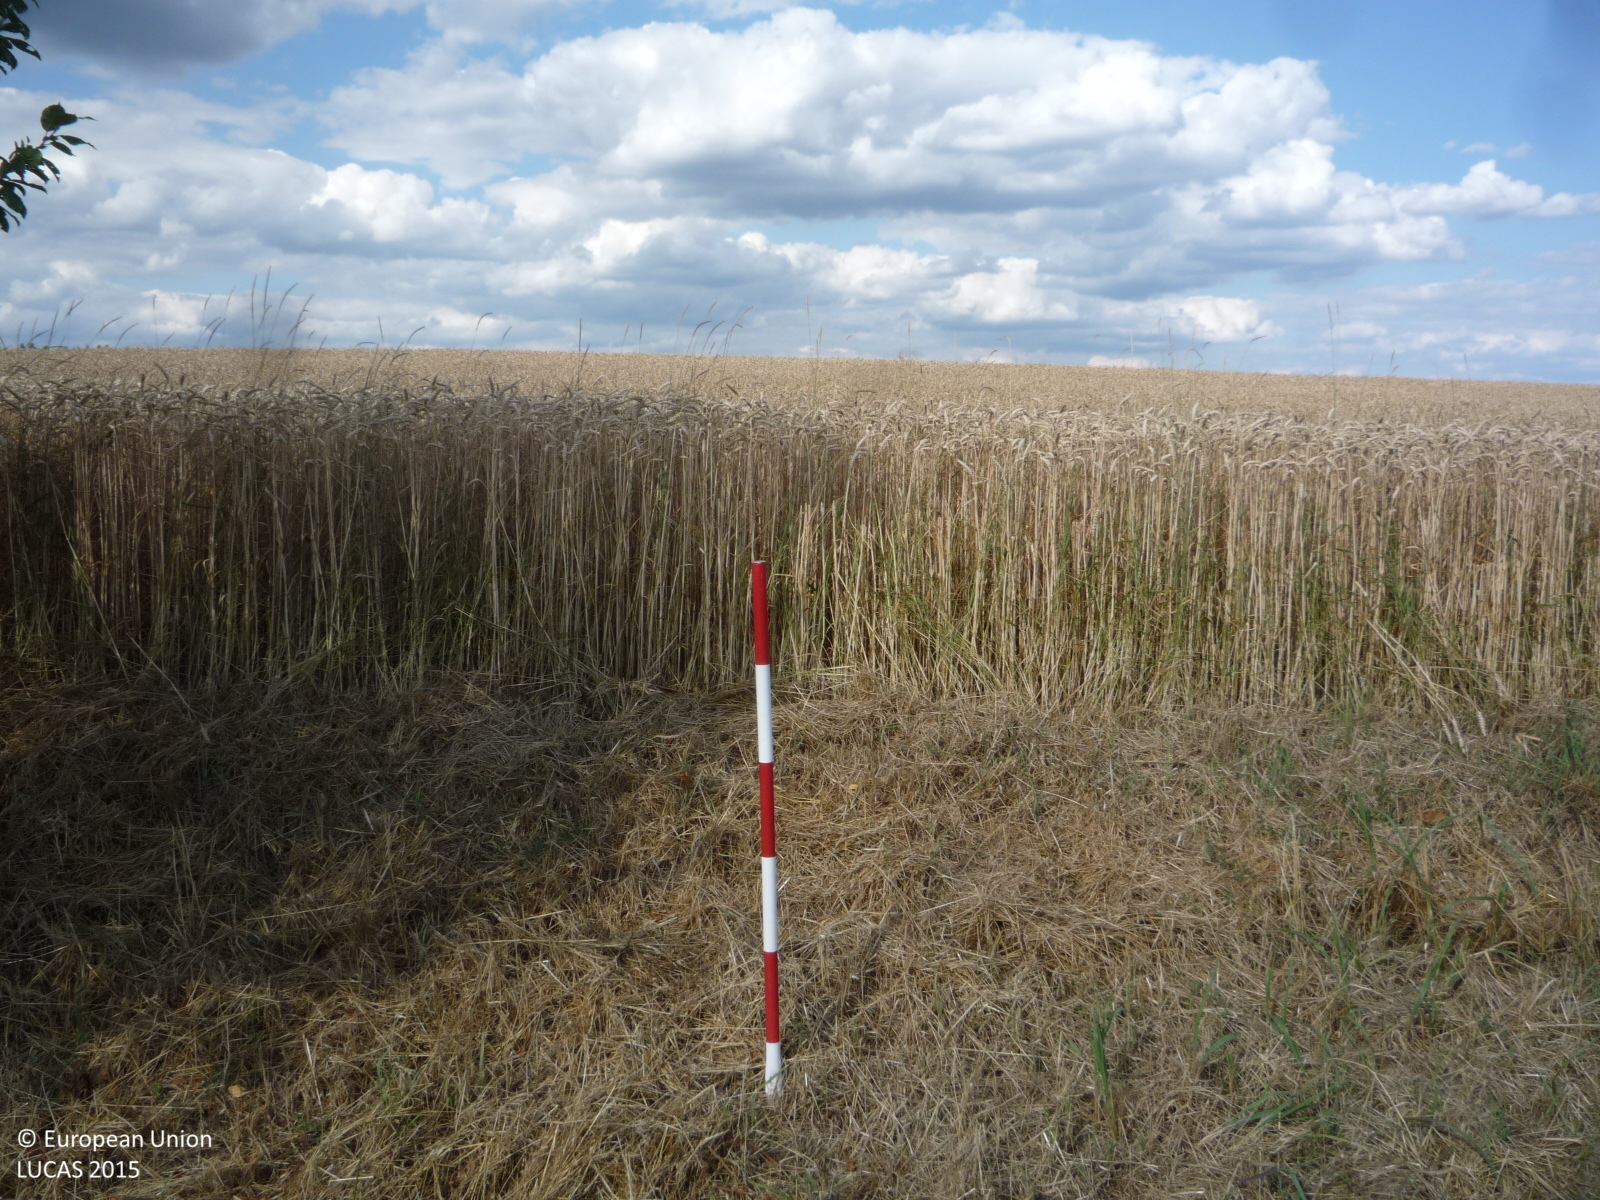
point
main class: Grassland
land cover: Grassland with sparse tree/shrub cover
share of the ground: > 75 %
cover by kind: herbaceous plants 95 %, broadleaved forest trees 5 %
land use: Agriculture (excluding fallow land and kitchen gardens)
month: July
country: CZ
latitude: 50.4761
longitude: 15.2878
